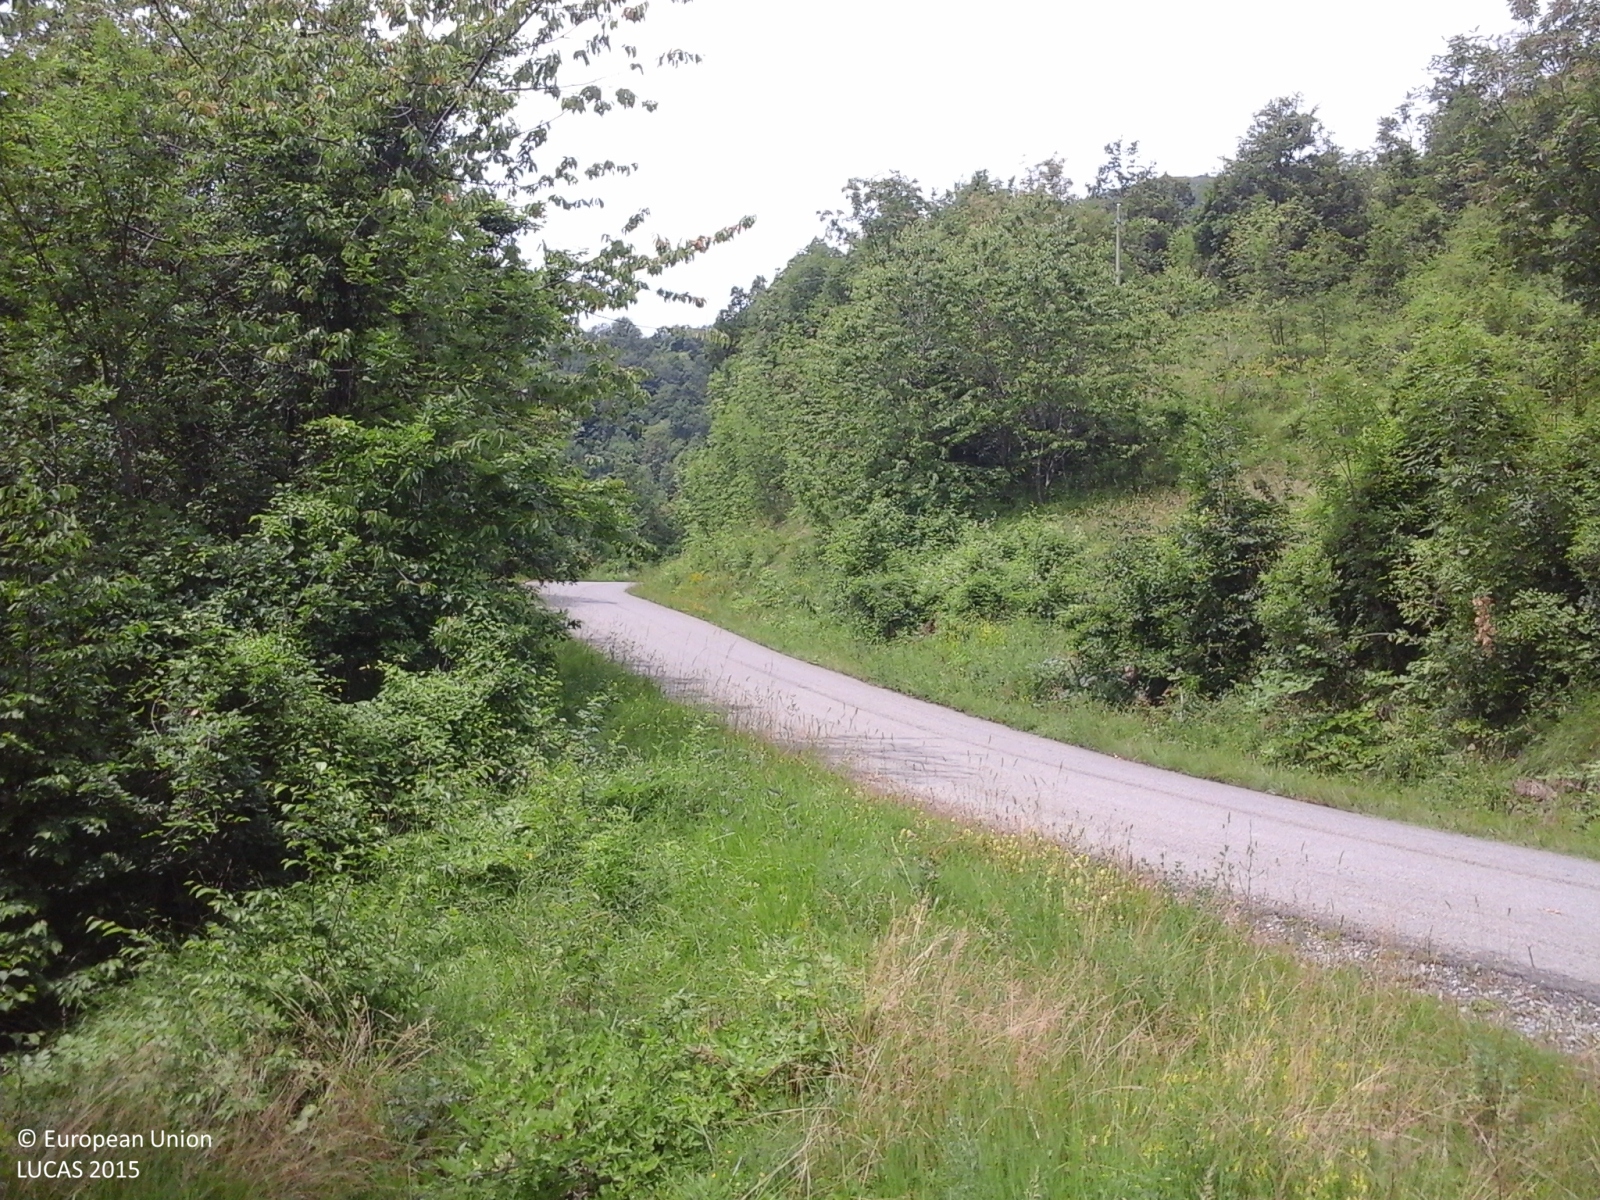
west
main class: Woodland
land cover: Broadleaved woodland
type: thermophilous deciduous forest
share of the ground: > 75 %
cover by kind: broadleaved forest trees 80 %, shrubs 20 %
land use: Forestry
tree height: > 5 m
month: June
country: IT
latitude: 44.6023
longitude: 9.6103
